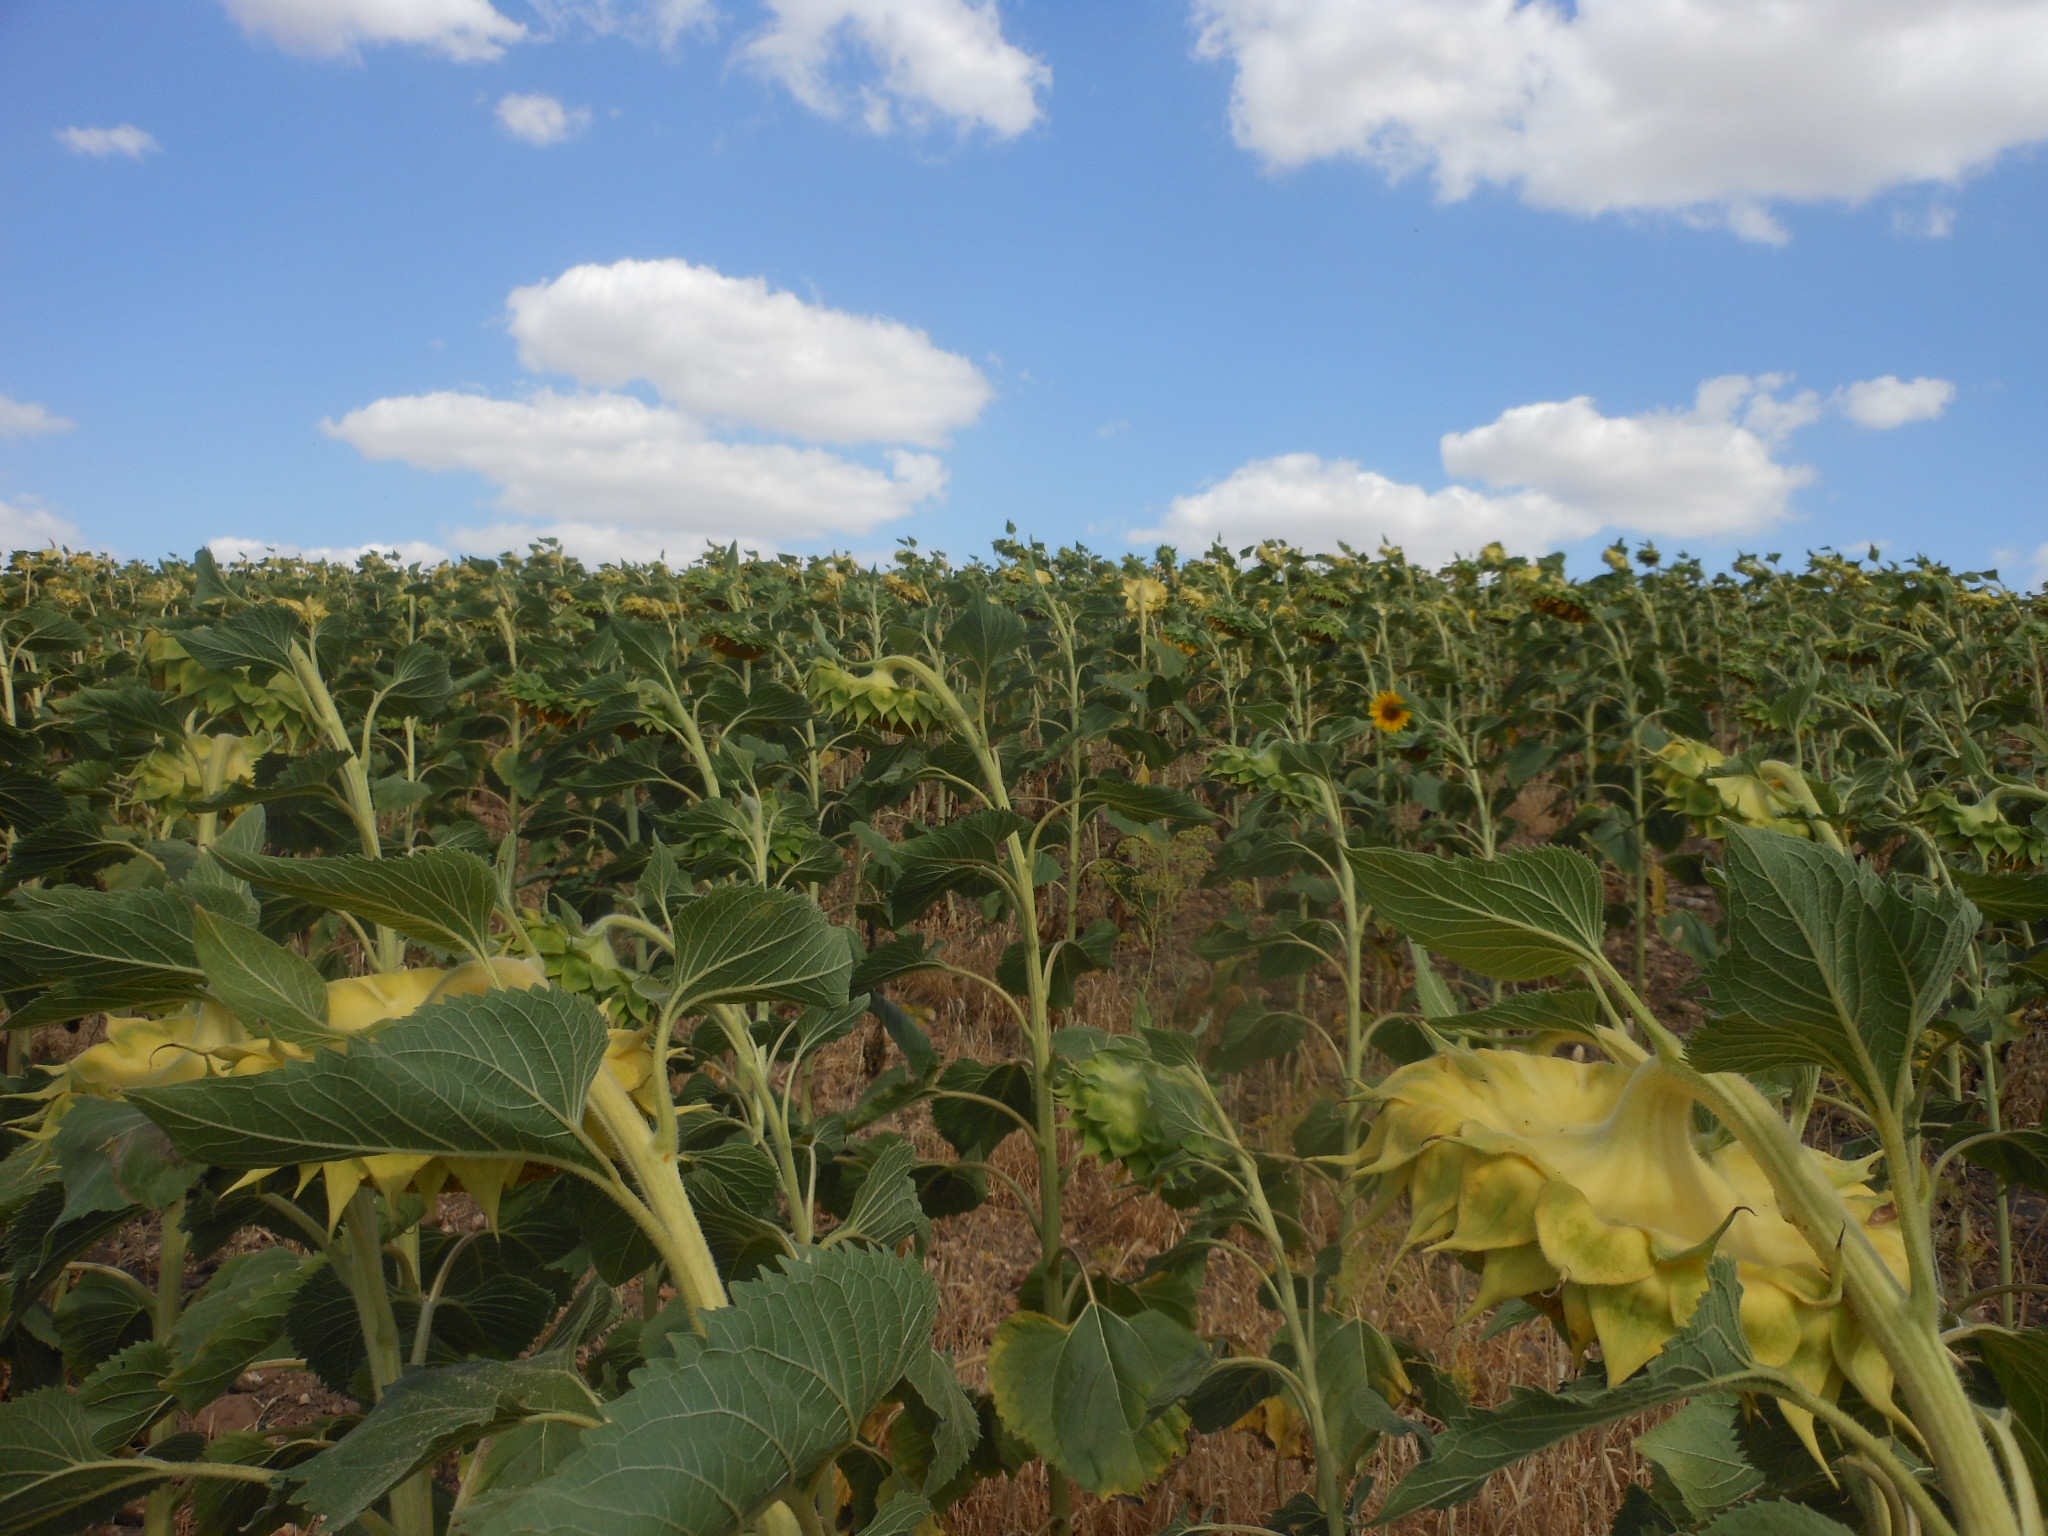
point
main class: Cropland
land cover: Sunflower
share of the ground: > 75 %
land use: Agriculture (excluding fallow land and kitchen gardens)
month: June
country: ES
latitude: 37.5927
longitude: -5.1569
